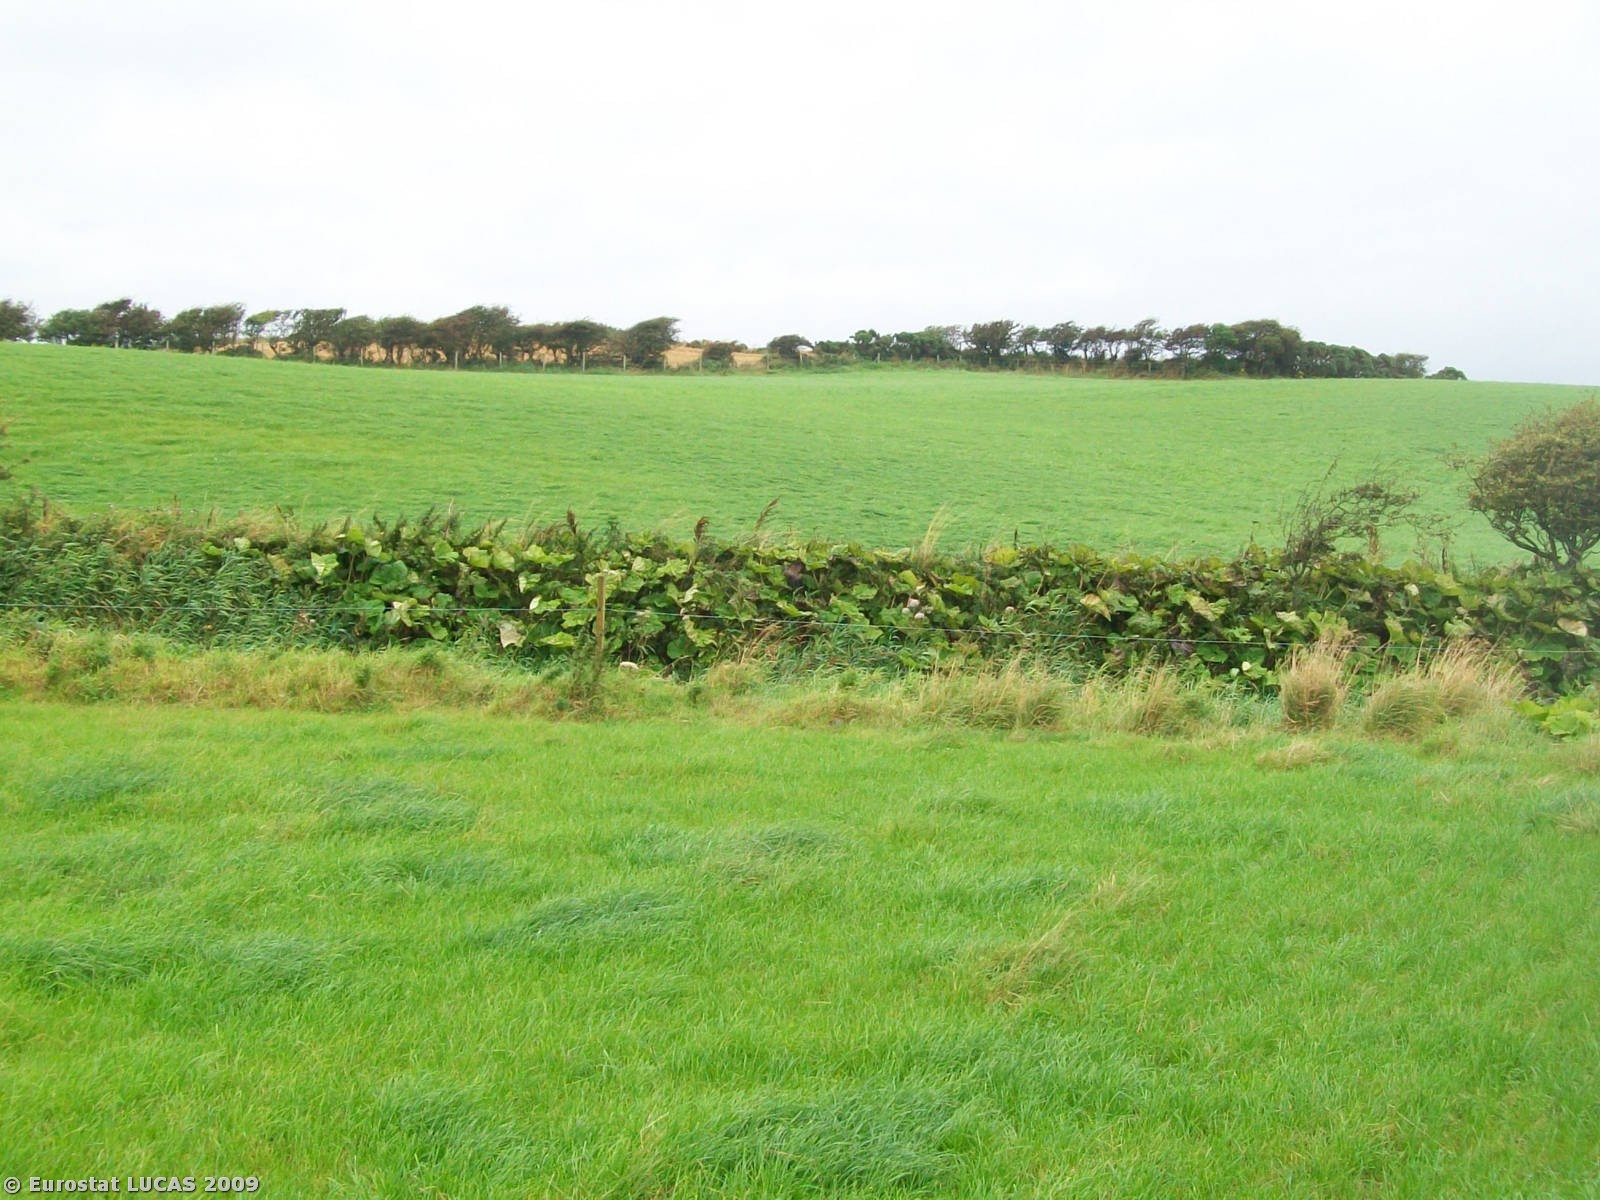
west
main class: Grassland
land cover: Spontaneously vegetated surfaces
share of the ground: > 75 %
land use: Fallow land
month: August
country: GB
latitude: 54.3142
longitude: -5.5468
